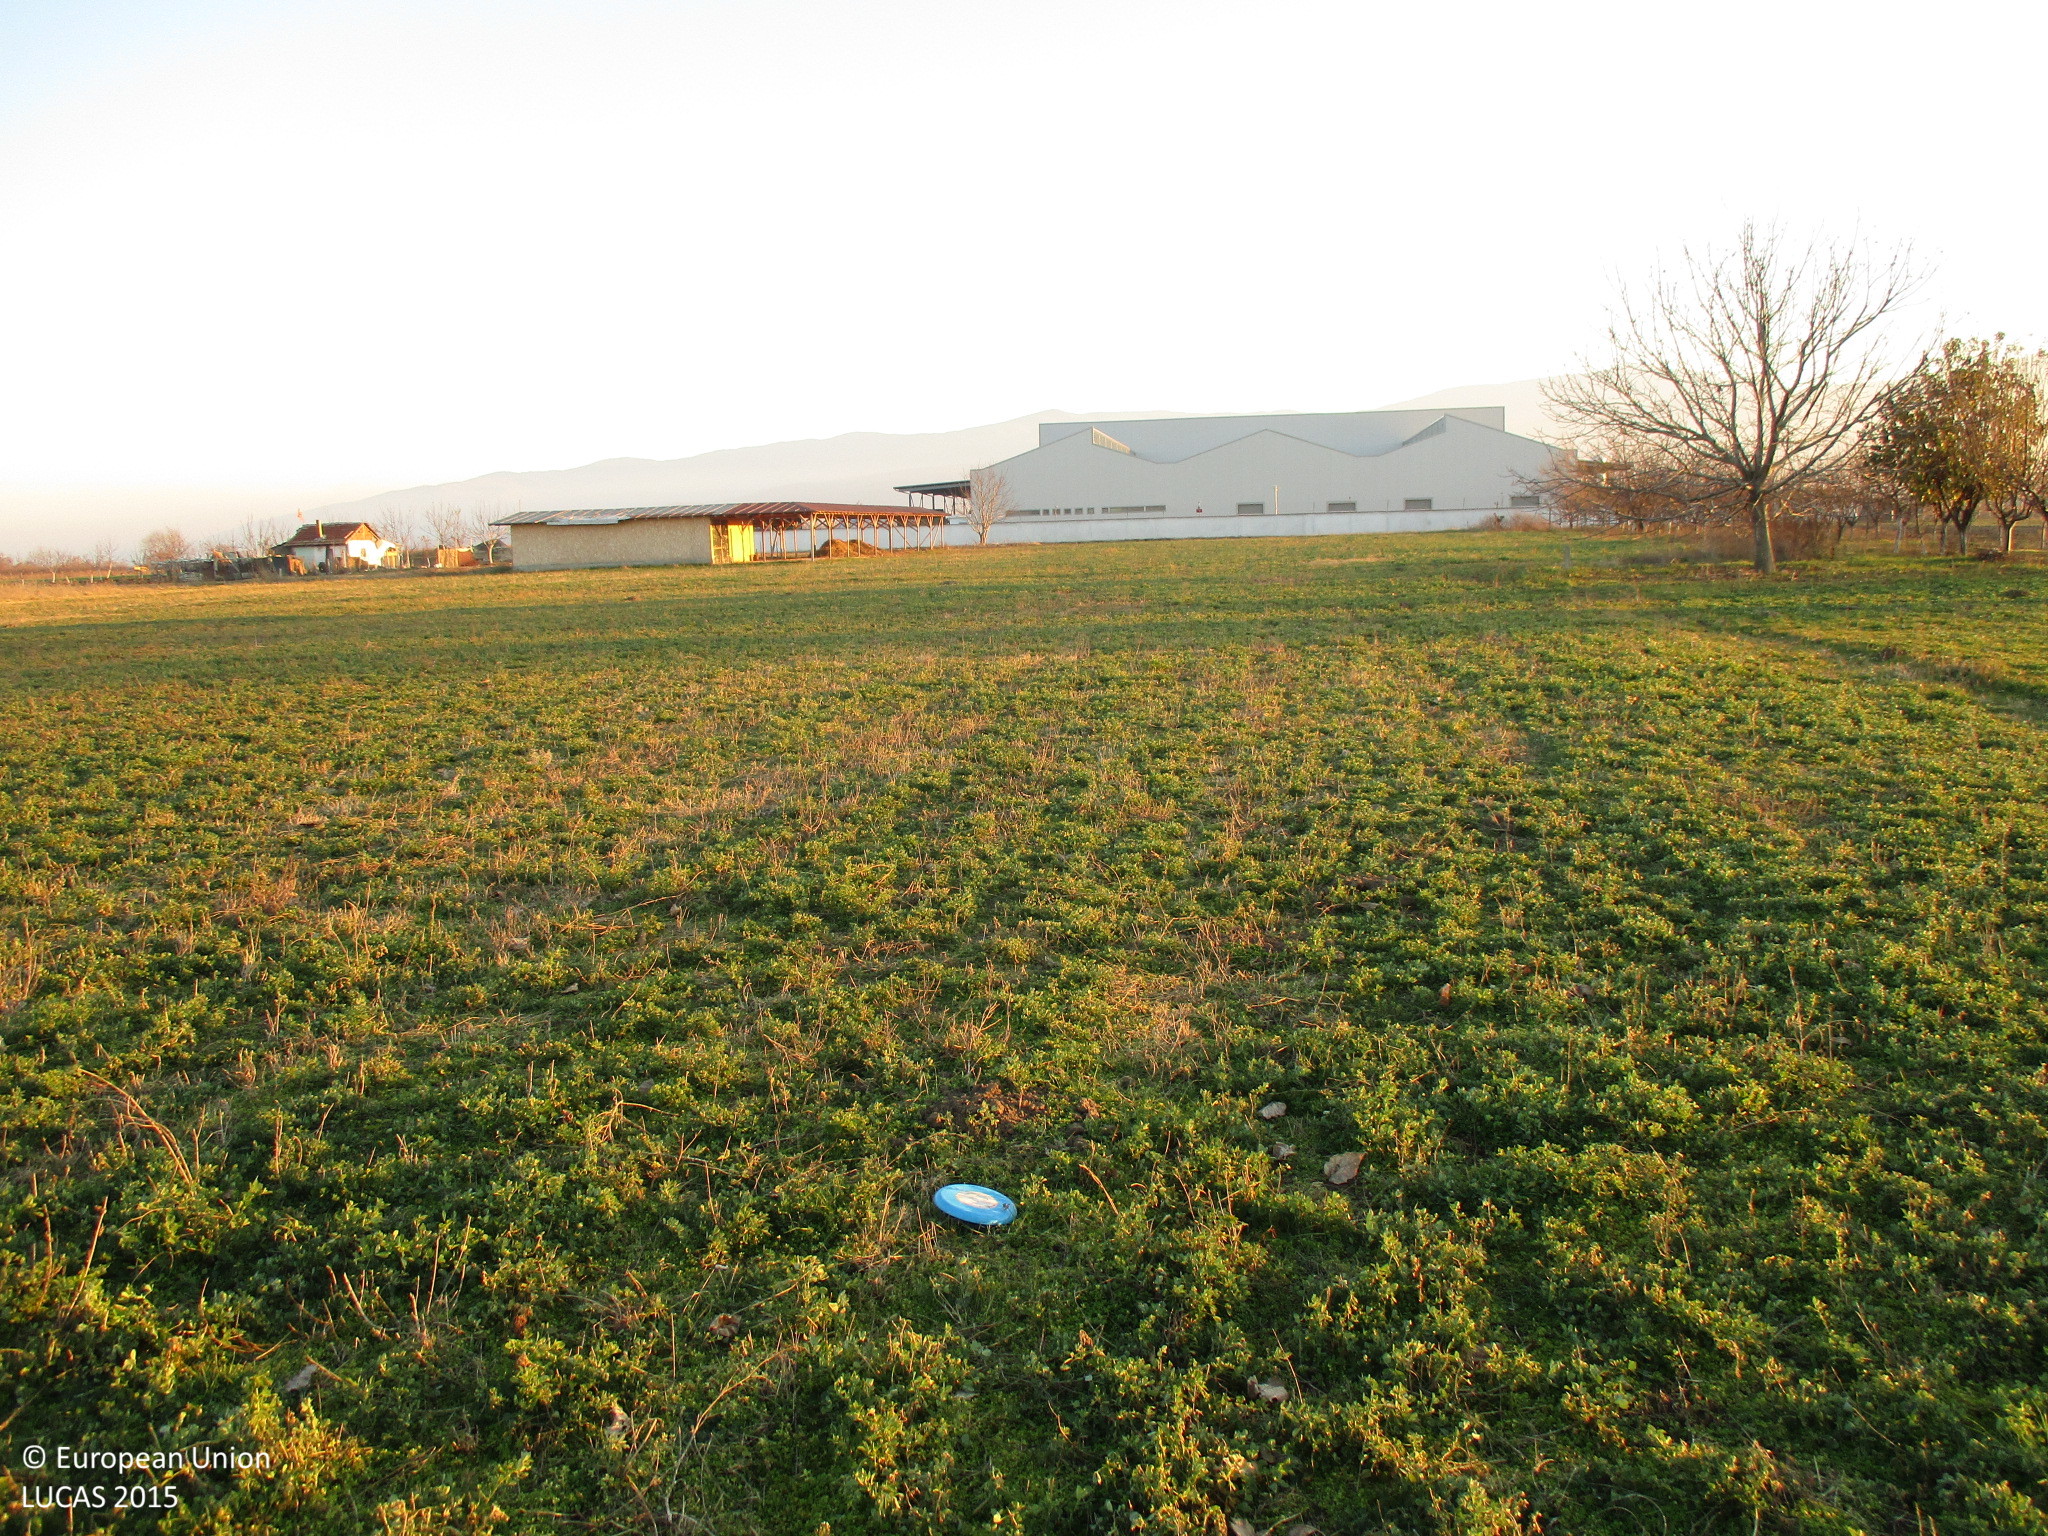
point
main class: Cropland
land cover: Lucerne
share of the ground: 50 - 75 %
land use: Agriculture (excluding fallow land and kitchen gardens)
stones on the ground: < 10 %
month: December
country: BG
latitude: 42.1245
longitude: 24.5759
